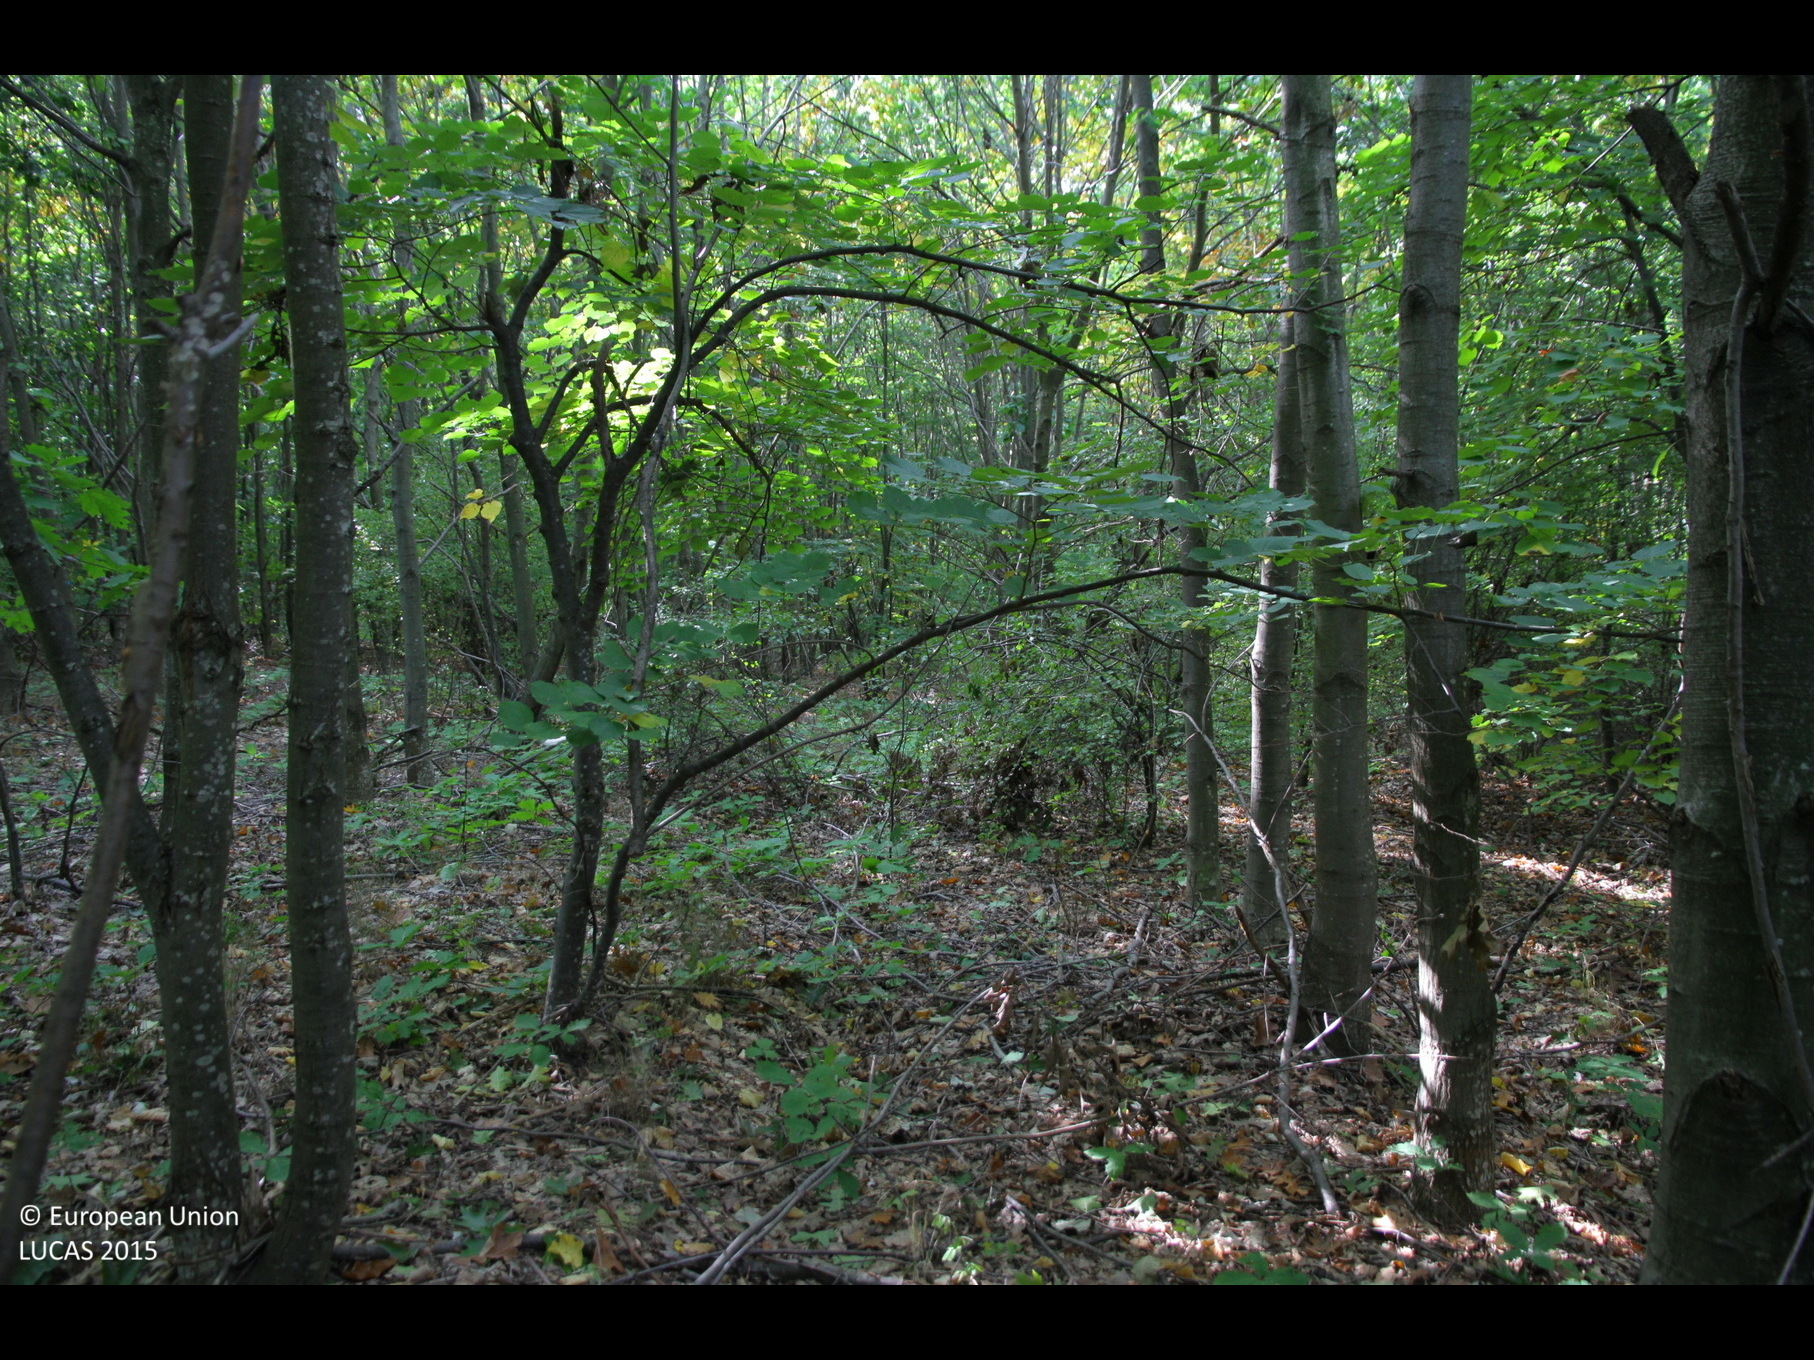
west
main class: Woodland
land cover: Broadleaved woodland
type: acidophilous oak and oak-birch forest
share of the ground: > 75 %
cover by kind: broadleaved forest trees 100 %
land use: Forestry
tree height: > 5 m
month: October
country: BG
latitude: 43.4863
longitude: 27.2236
